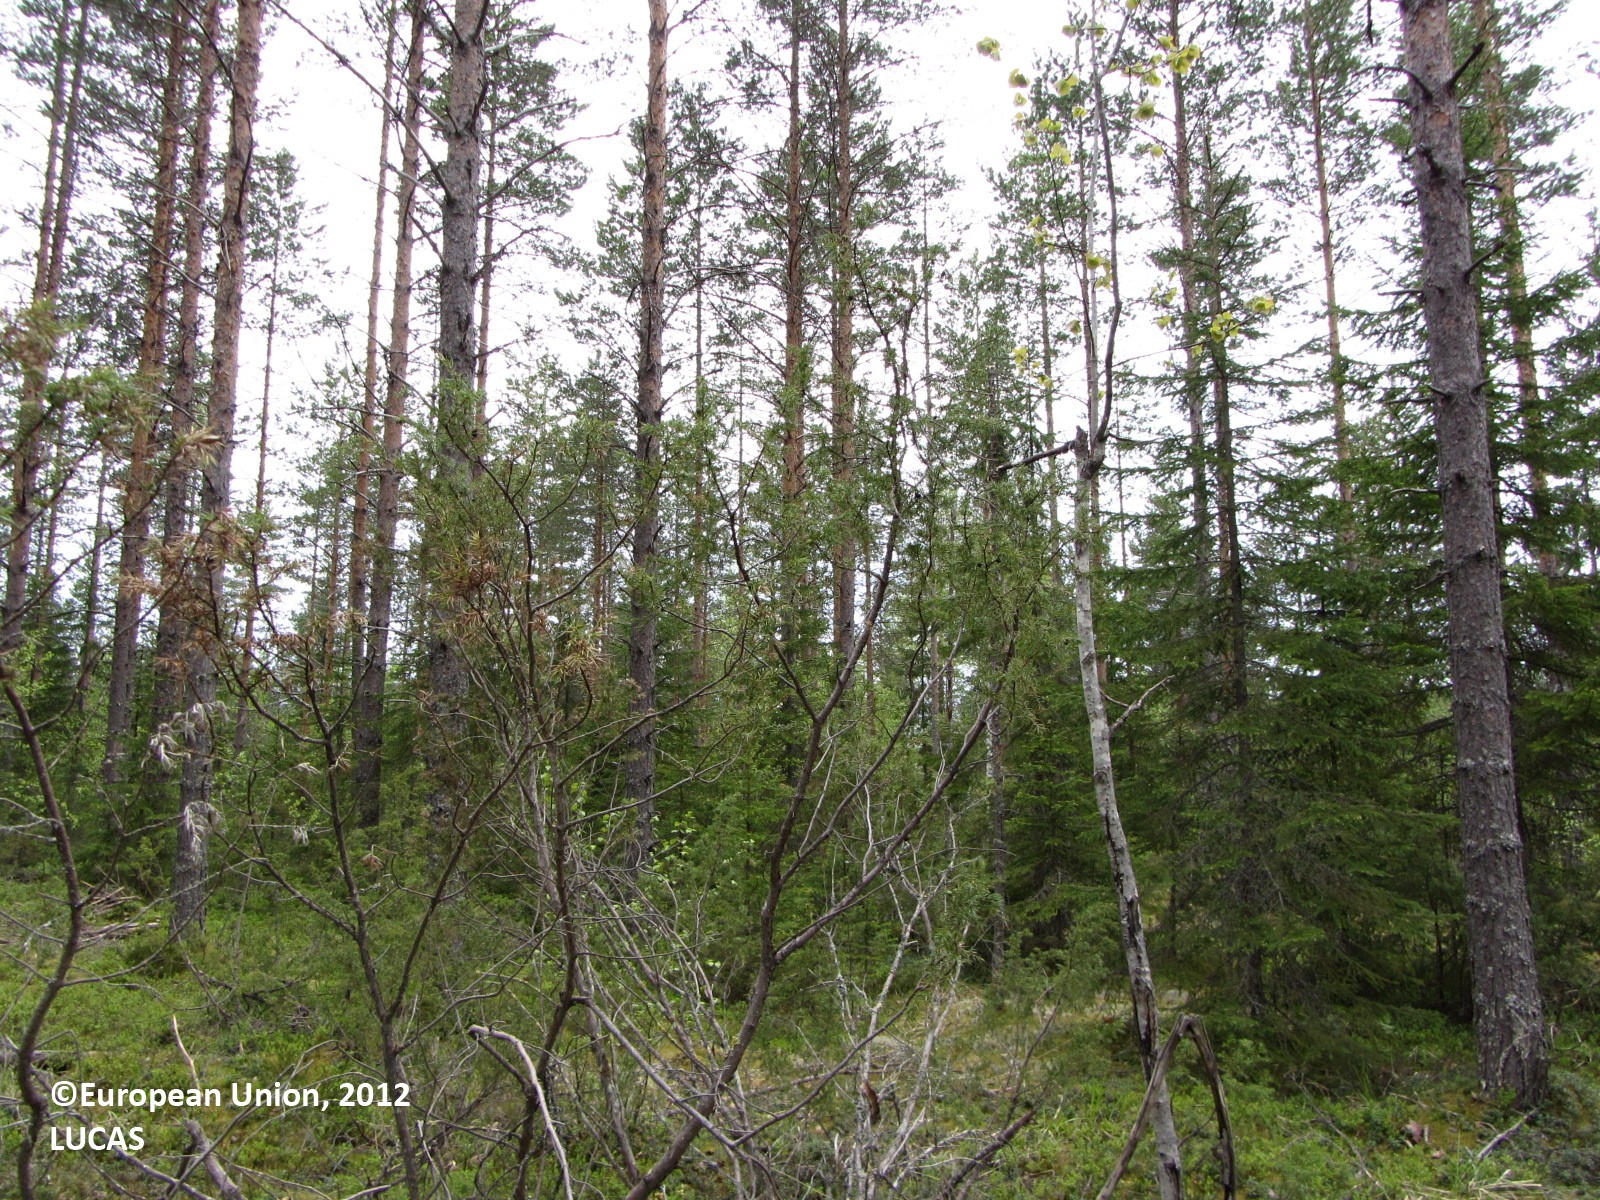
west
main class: Woodland
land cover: Pine dominated mixed woodland
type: boreal forest
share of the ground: > 75 %
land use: Forestry
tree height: > 5 m
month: May
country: FI
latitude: 62.3314
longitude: 25.3798
